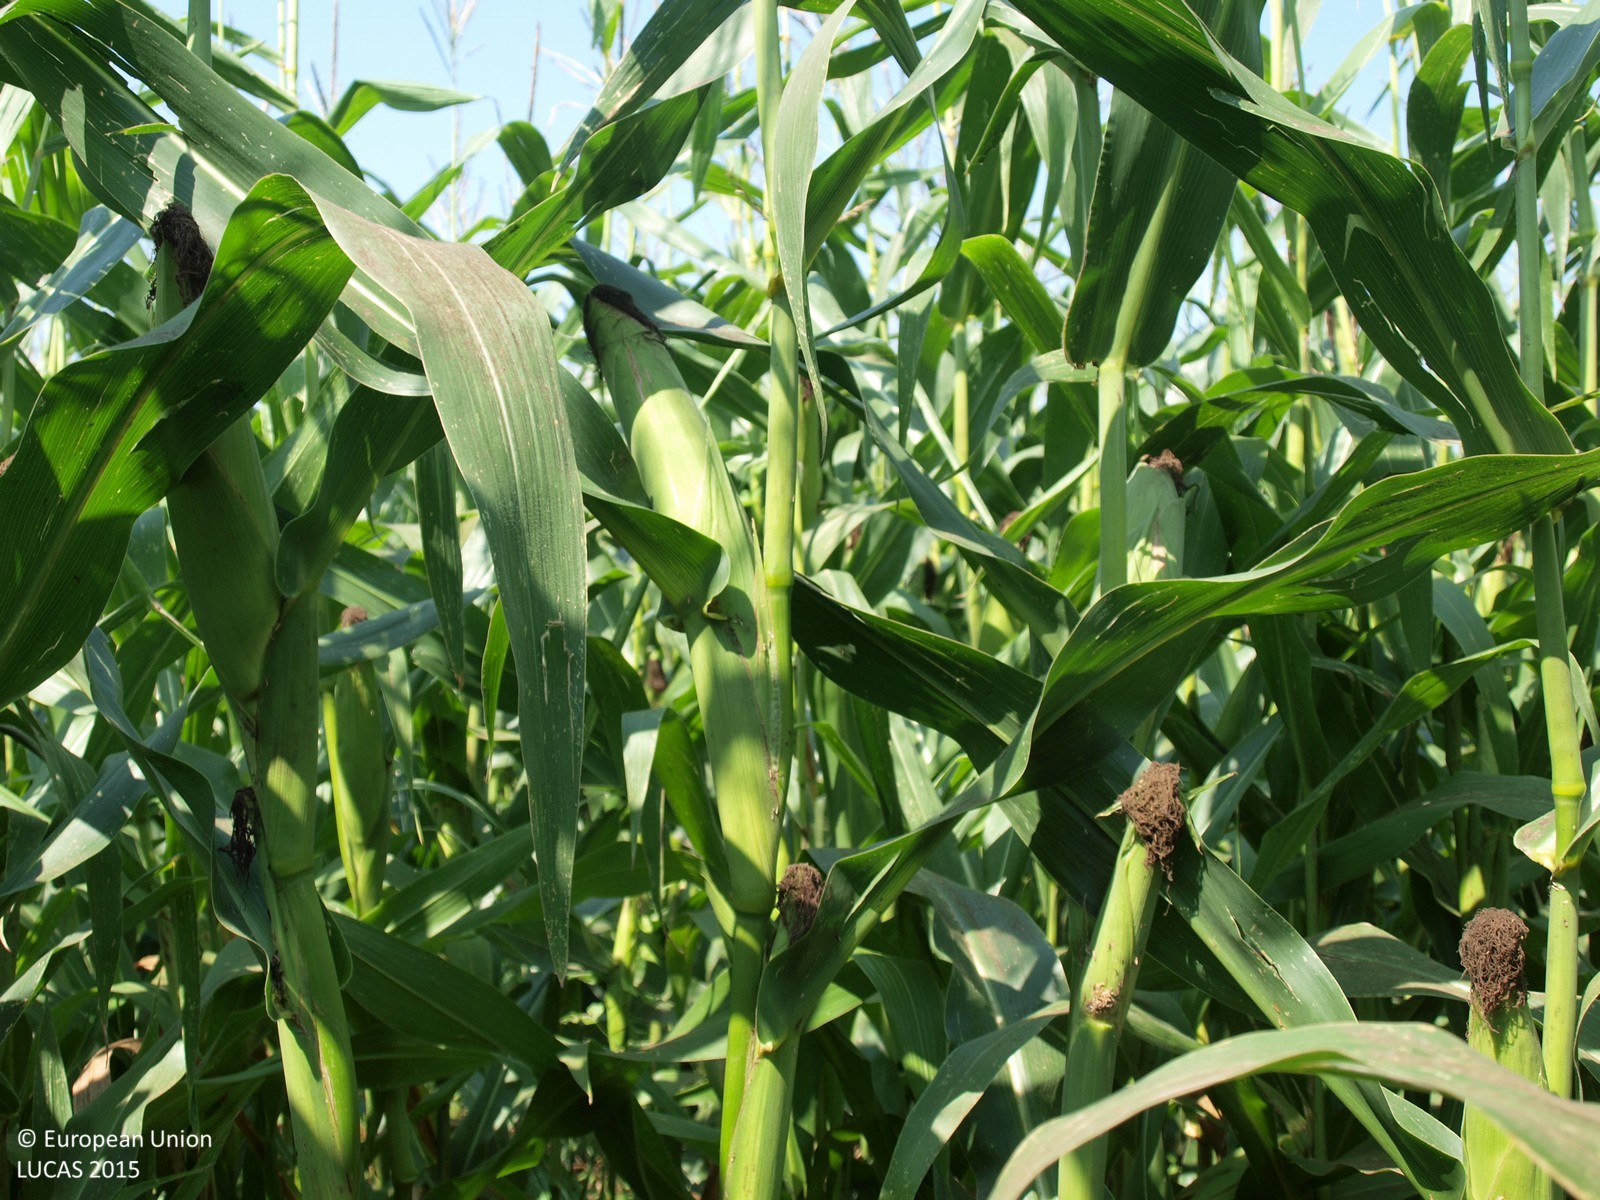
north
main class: Cropland
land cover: Maize
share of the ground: > 75 %
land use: Agriculture (excluding fallow land and kitchen gardens)
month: August
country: HR
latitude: 45.9263
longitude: 16.6669
